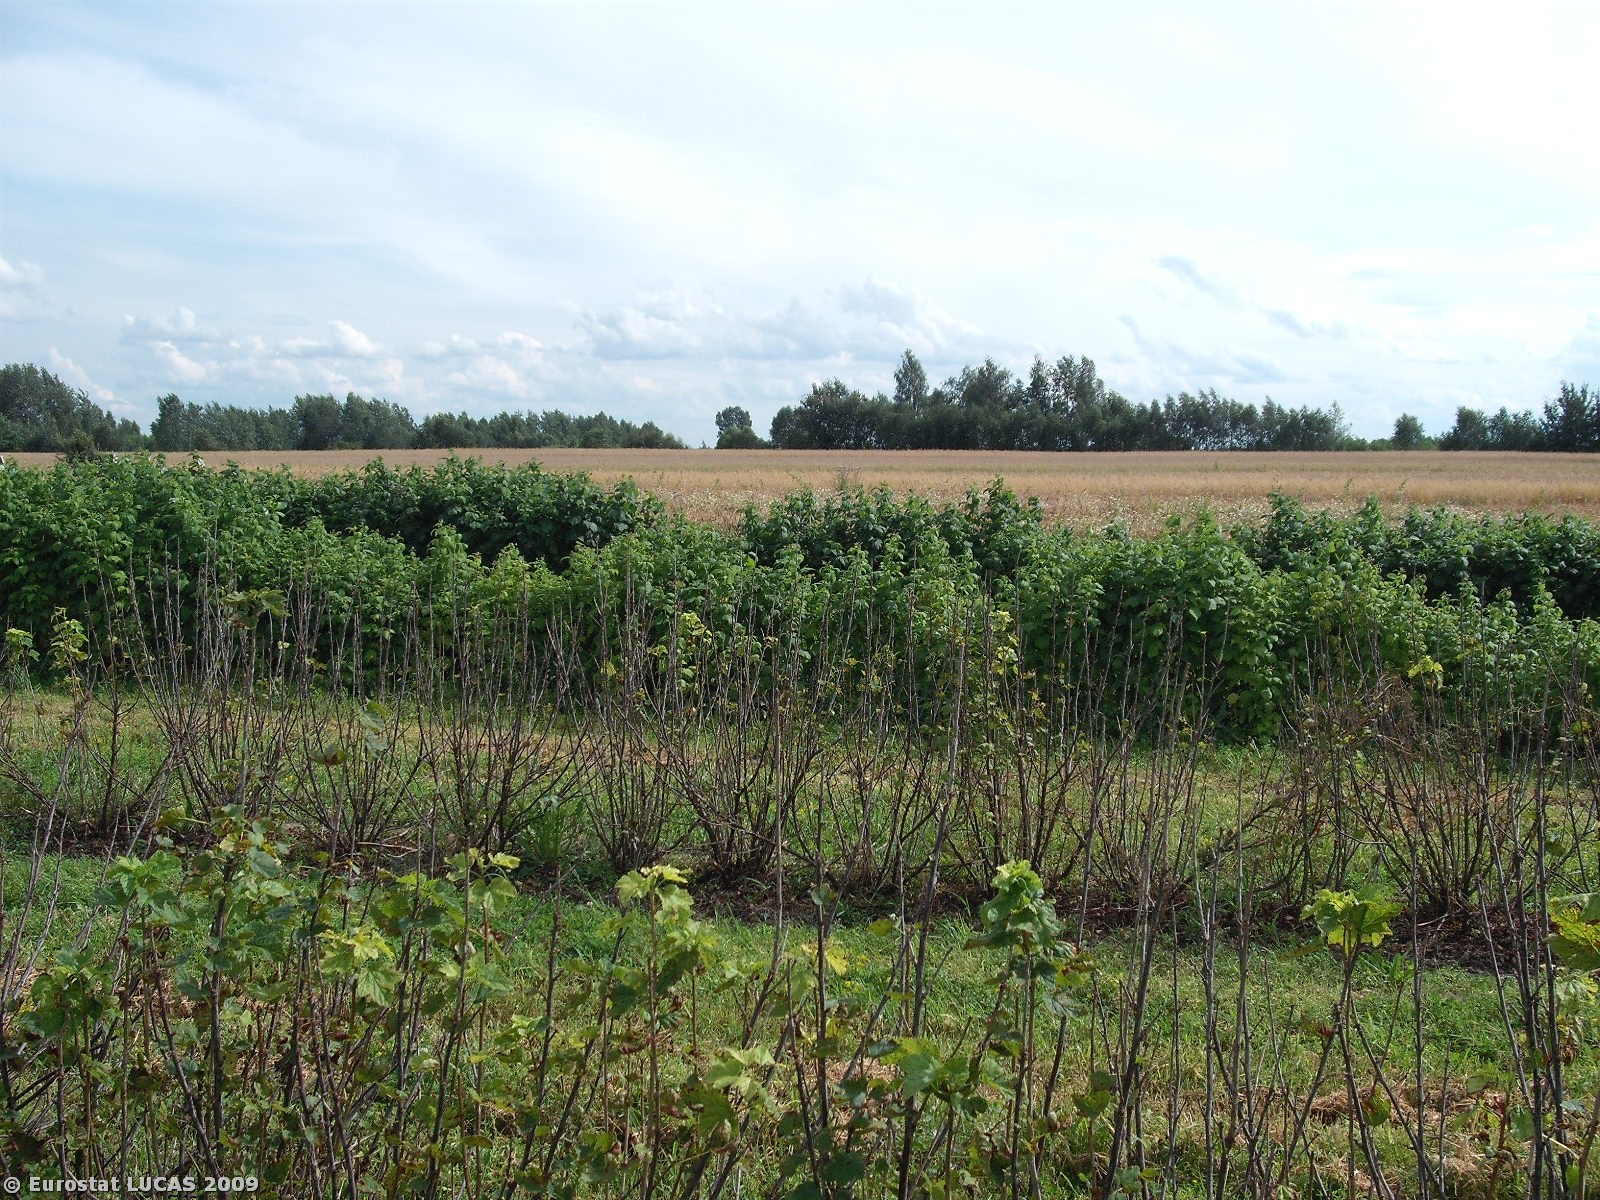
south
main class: Cropland
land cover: Other fruit trees and berries
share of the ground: 25 - 50 %
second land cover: Grassland with sparse tree/shrub cover
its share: > 75 %
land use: Agriculture (excluding fallow land and kitchen gardens)
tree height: < 5 m
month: July
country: PL
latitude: 51.0995
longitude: 21.4026
